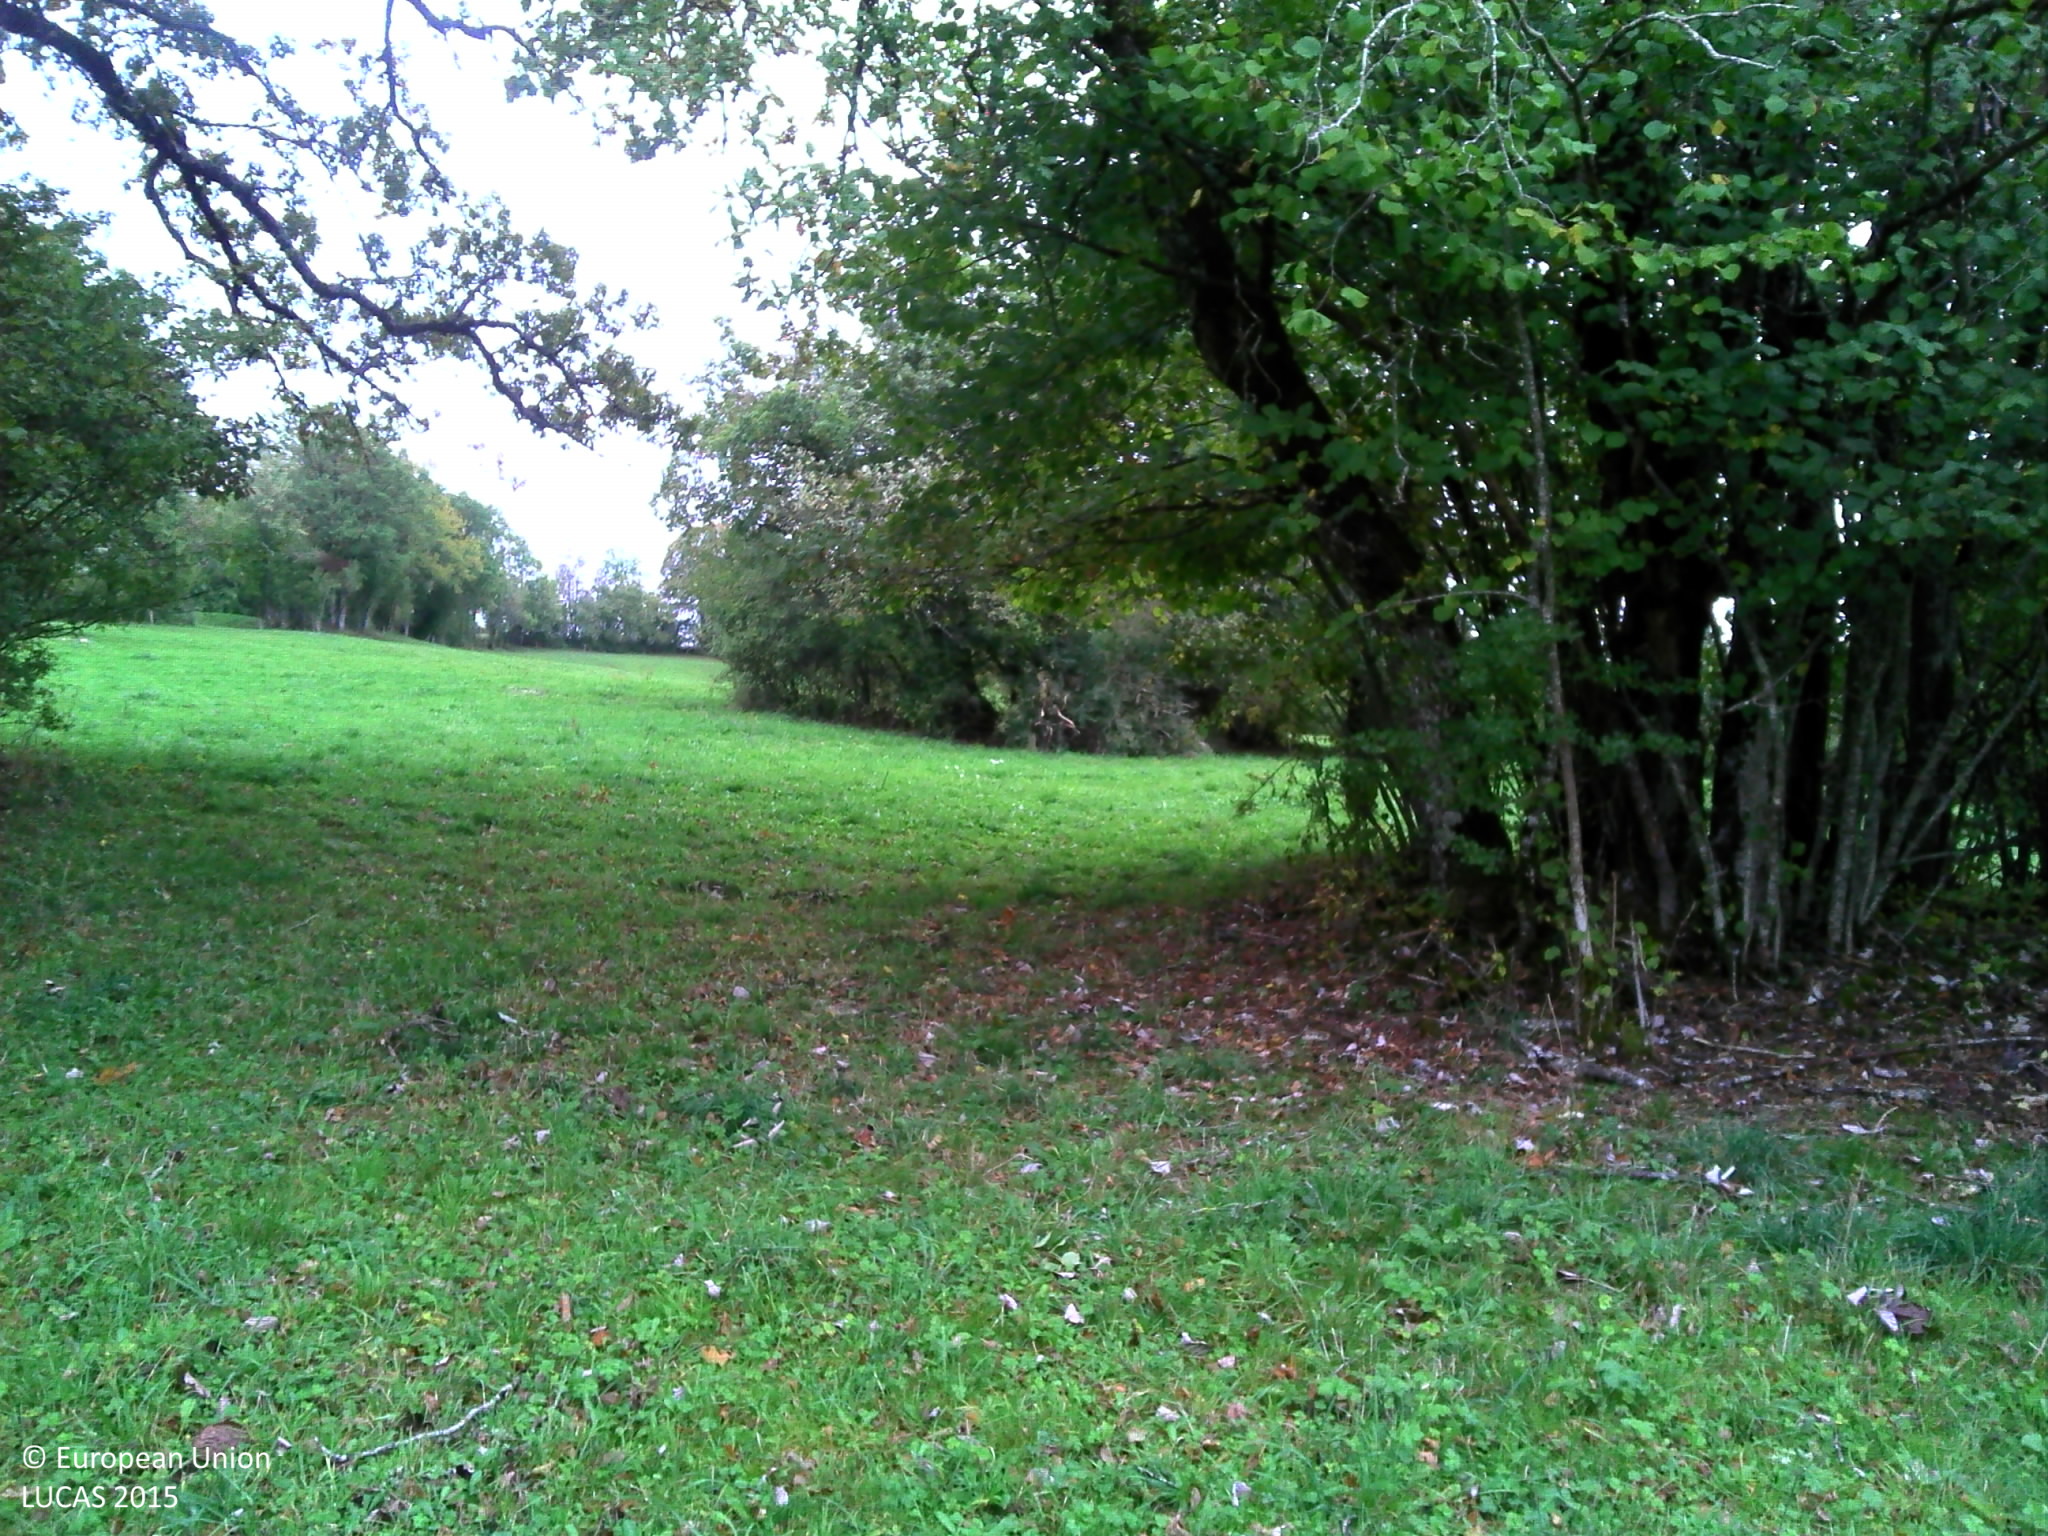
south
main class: Grassland
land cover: Grassland without tree/shrub cover
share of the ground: > 75 %
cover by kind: herbaceous plants 100 %
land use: Agriculture (excluding fallow land and kitchen gardens)
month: October
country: FR
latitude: 47.0076
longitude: 6.2799
